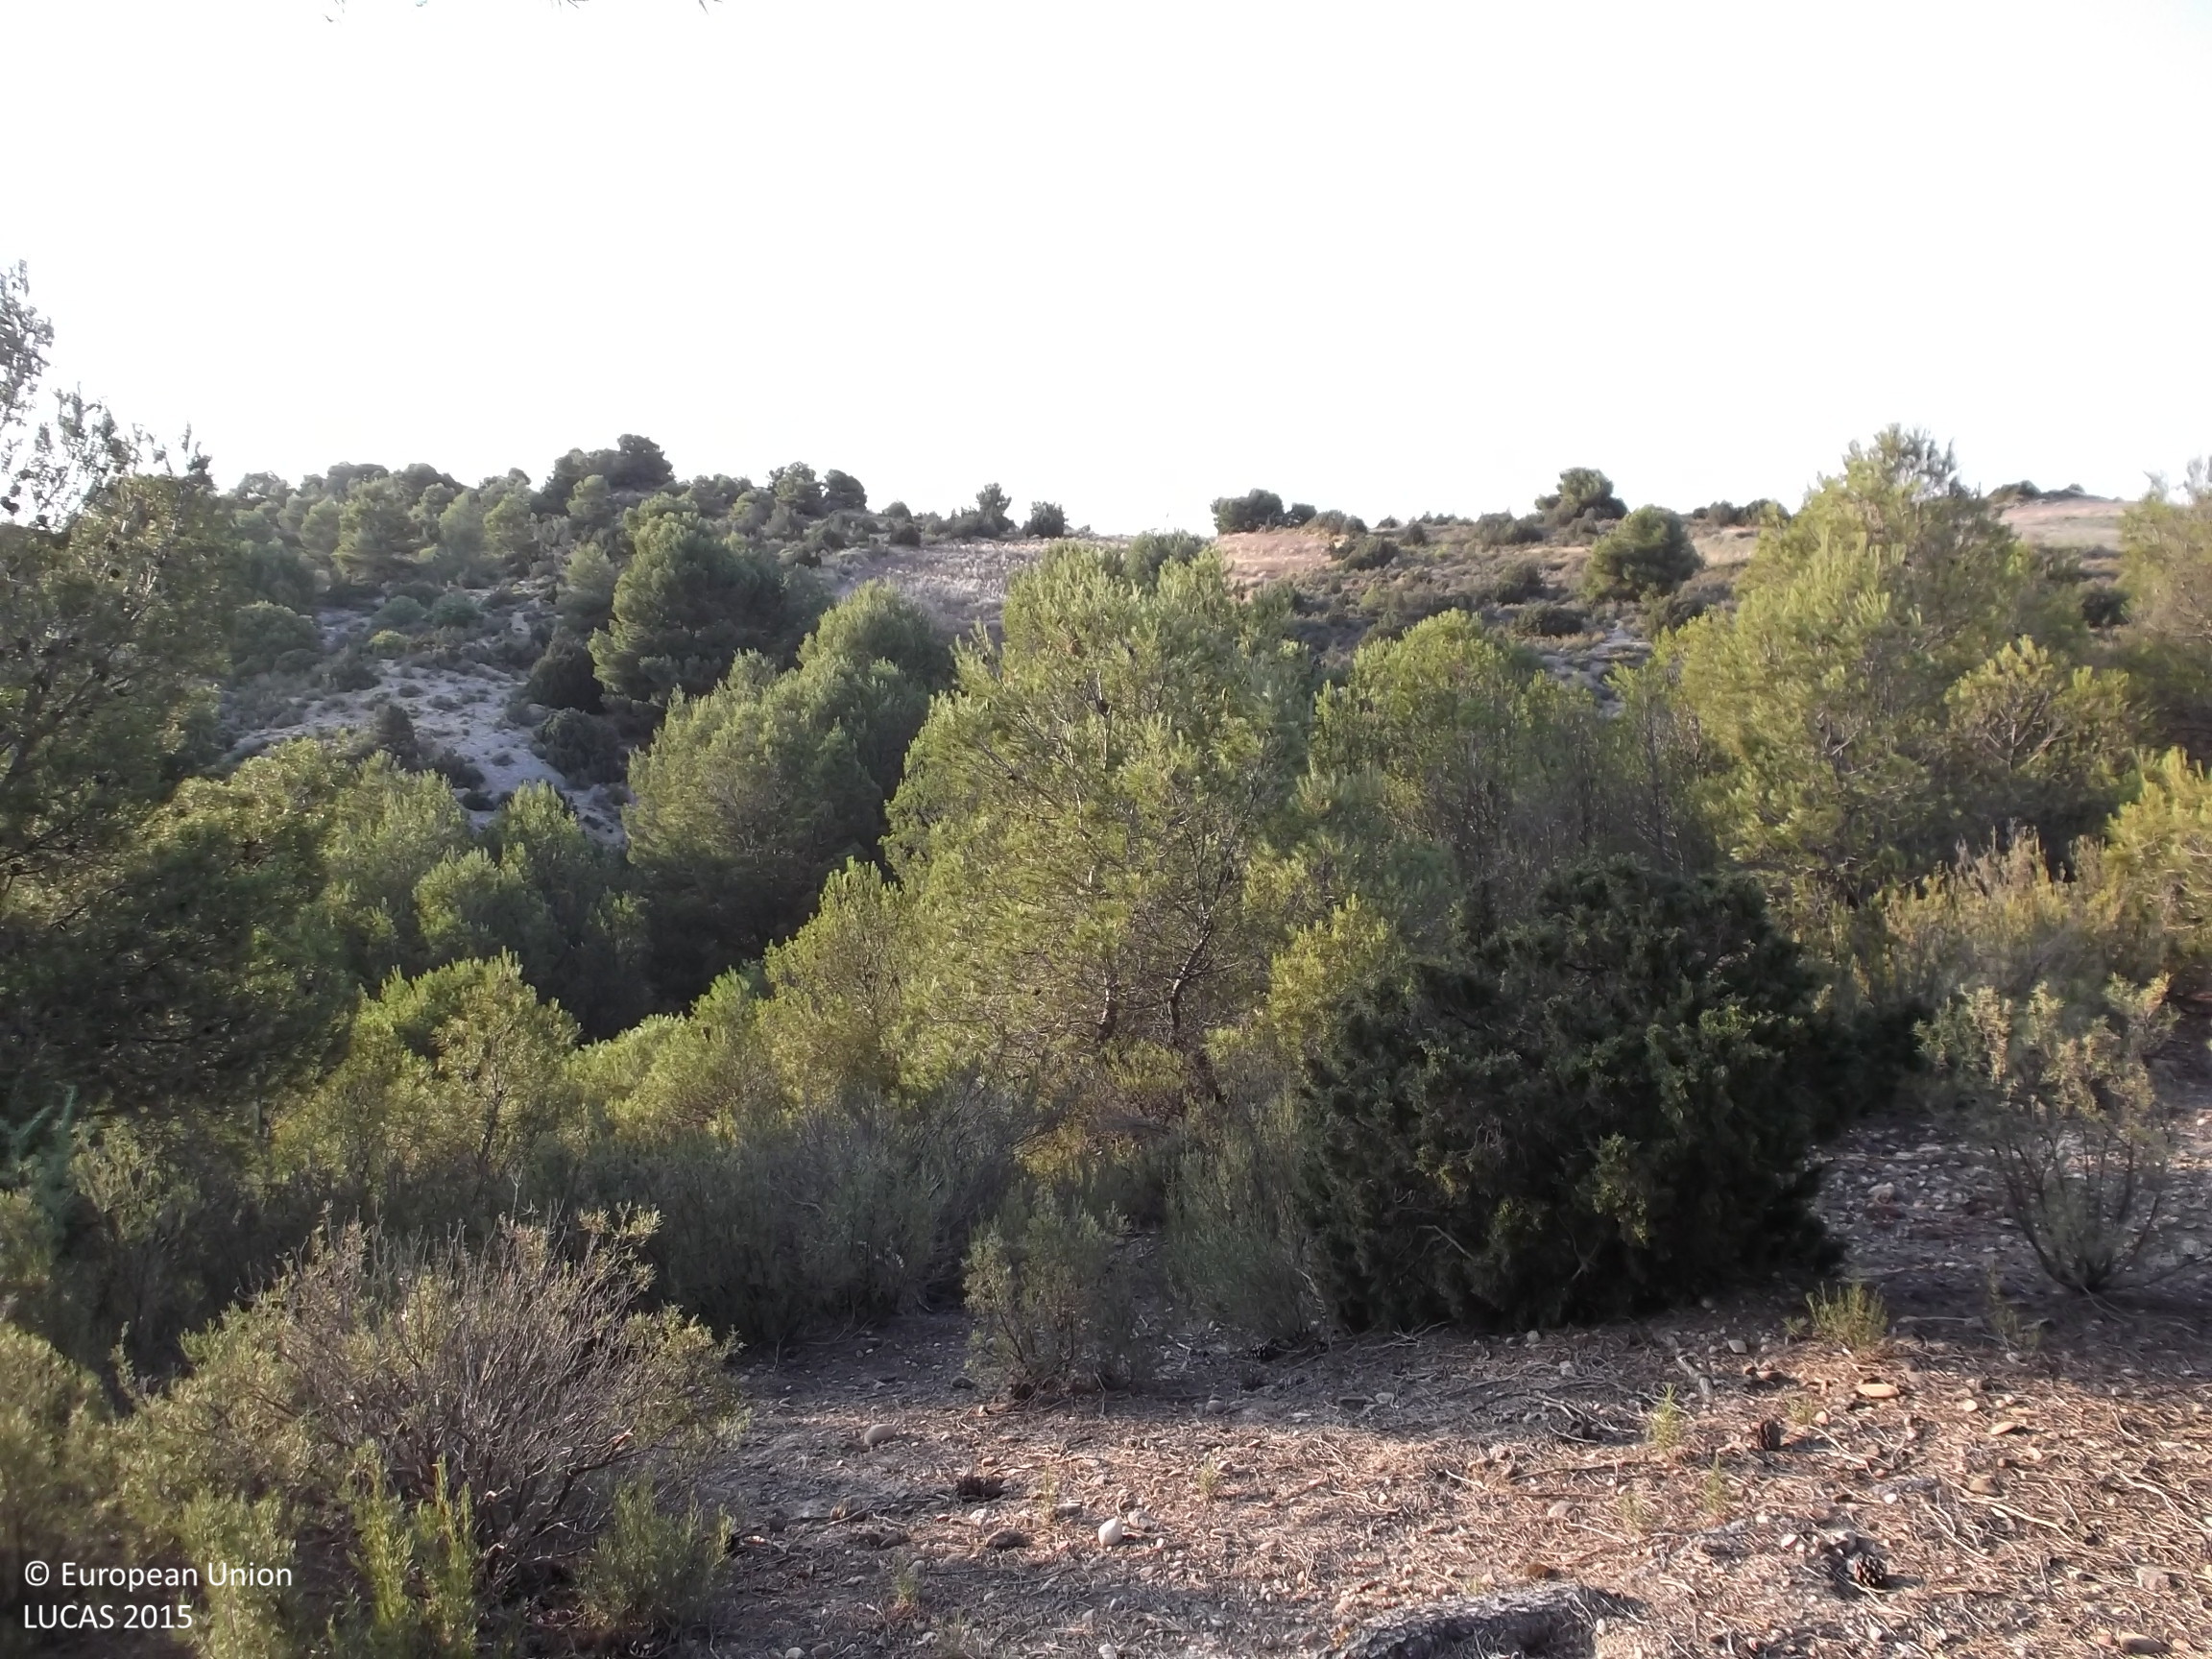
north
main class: Woodland
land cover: Pine dominated coniferous woodland
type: coniferous forest of the mediterranean region
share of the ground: > 75 %
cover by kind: coniferous forest trees 75 %, shrubs 10 %, unconsolidated bare surface 10 %, herbaceous plants 5 %
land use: Semi-natural and natural areas not in use
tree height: > 5 m
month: July
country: ES
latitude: 42.2903
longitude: -1.6409
